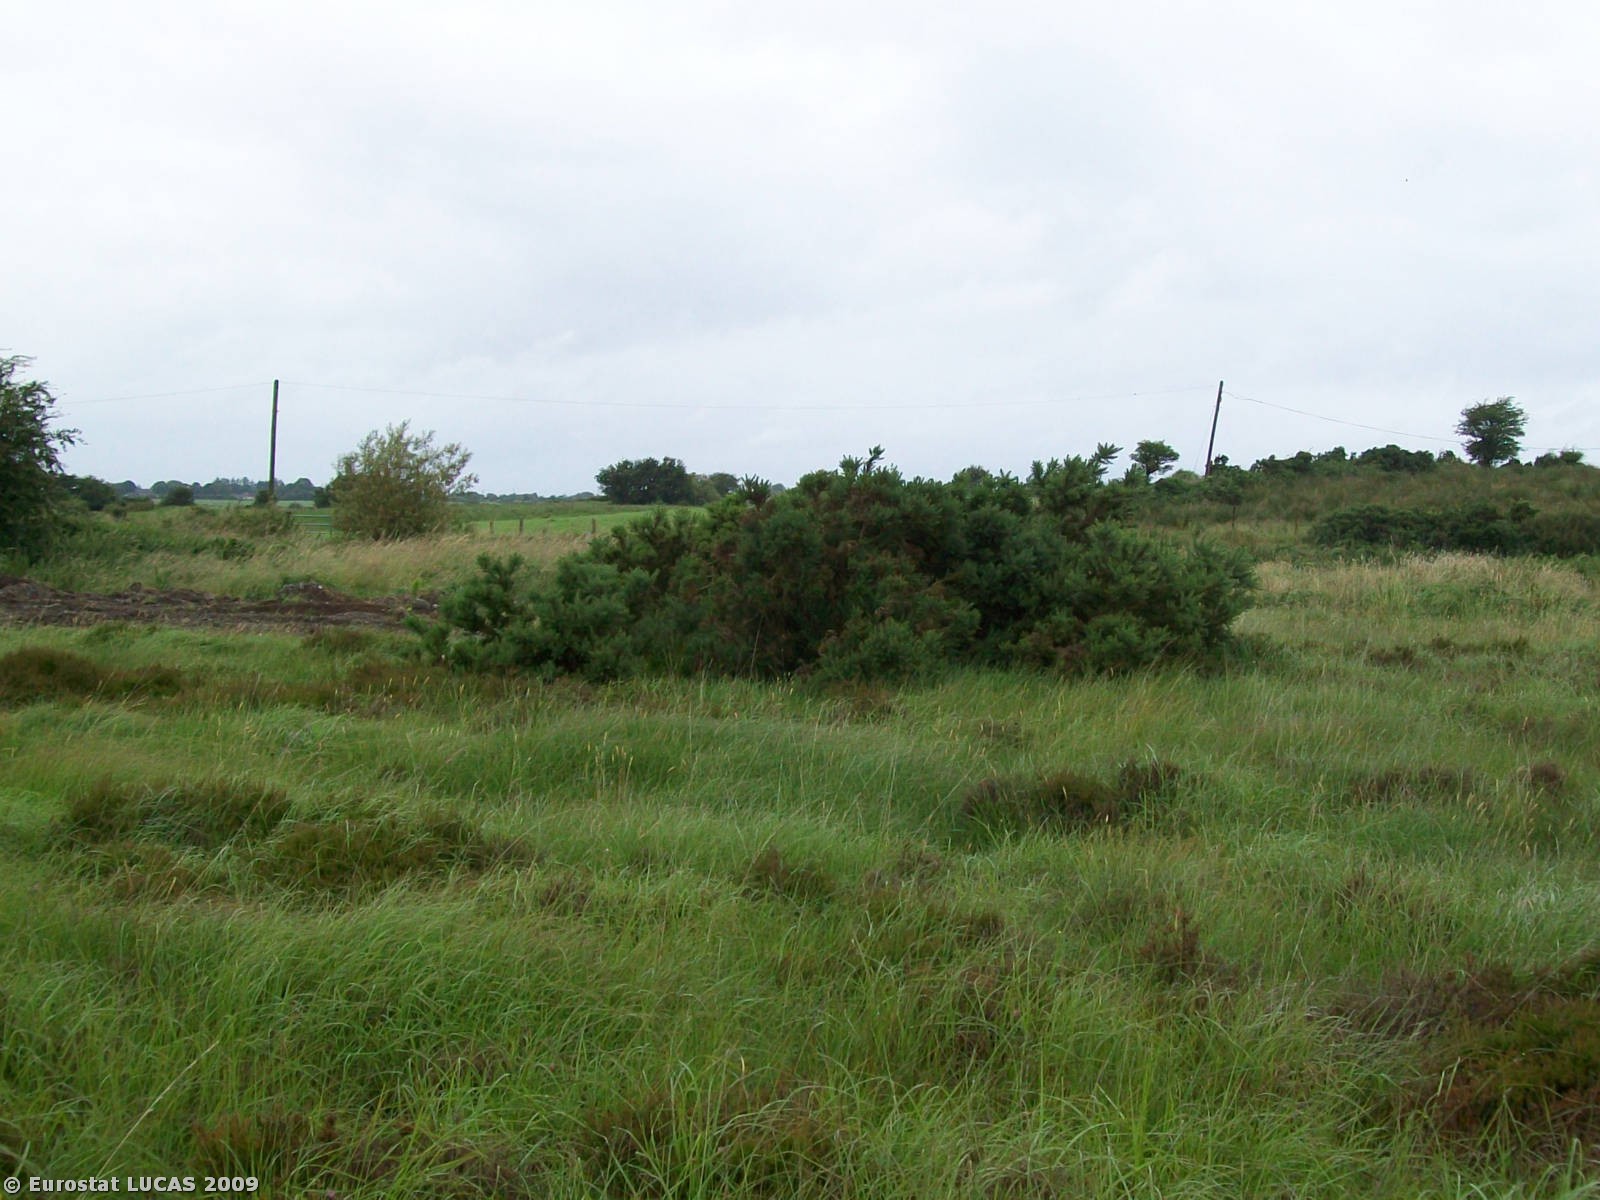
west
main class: Grassland
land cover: Grassland without tree/shrub cover
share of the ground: > 75 %
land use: Agriculture (excluding fallow land and kitchen gardens)
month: July
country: IE
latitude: 53.6474
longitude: -8.9225
